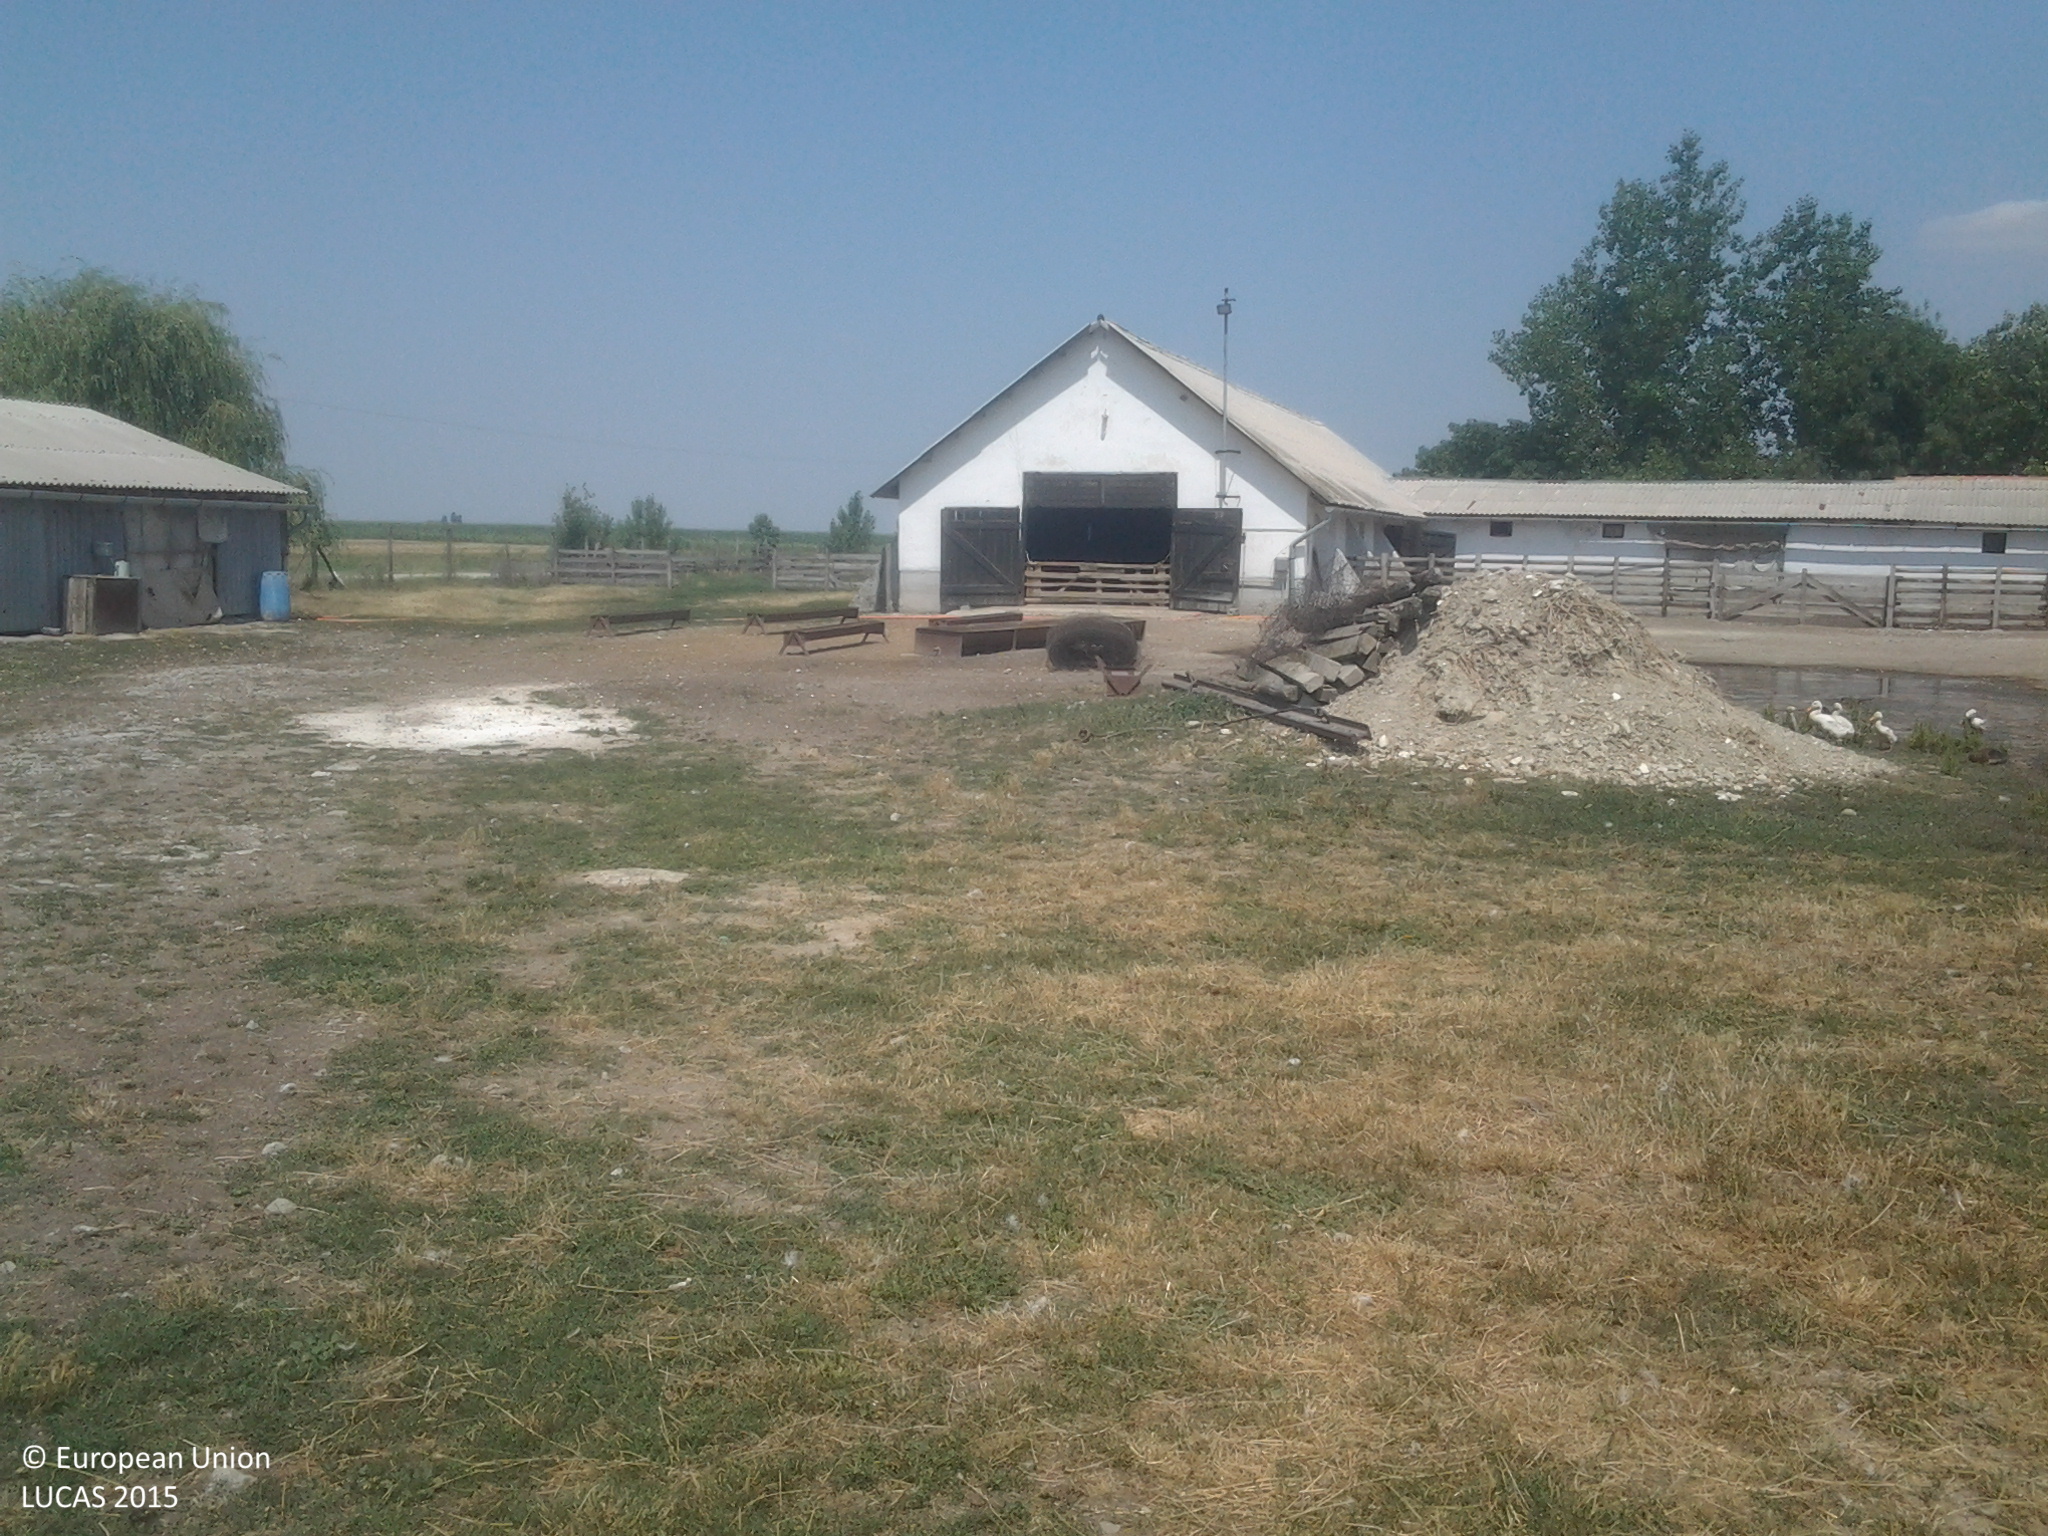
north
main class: Grassland
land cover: Grassland without tree/shrub cover
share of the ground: > 75 %
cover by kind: herbaceous plants 100 %
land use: Residential
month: July
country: HU
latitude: 47.0464
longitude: 19.1384
